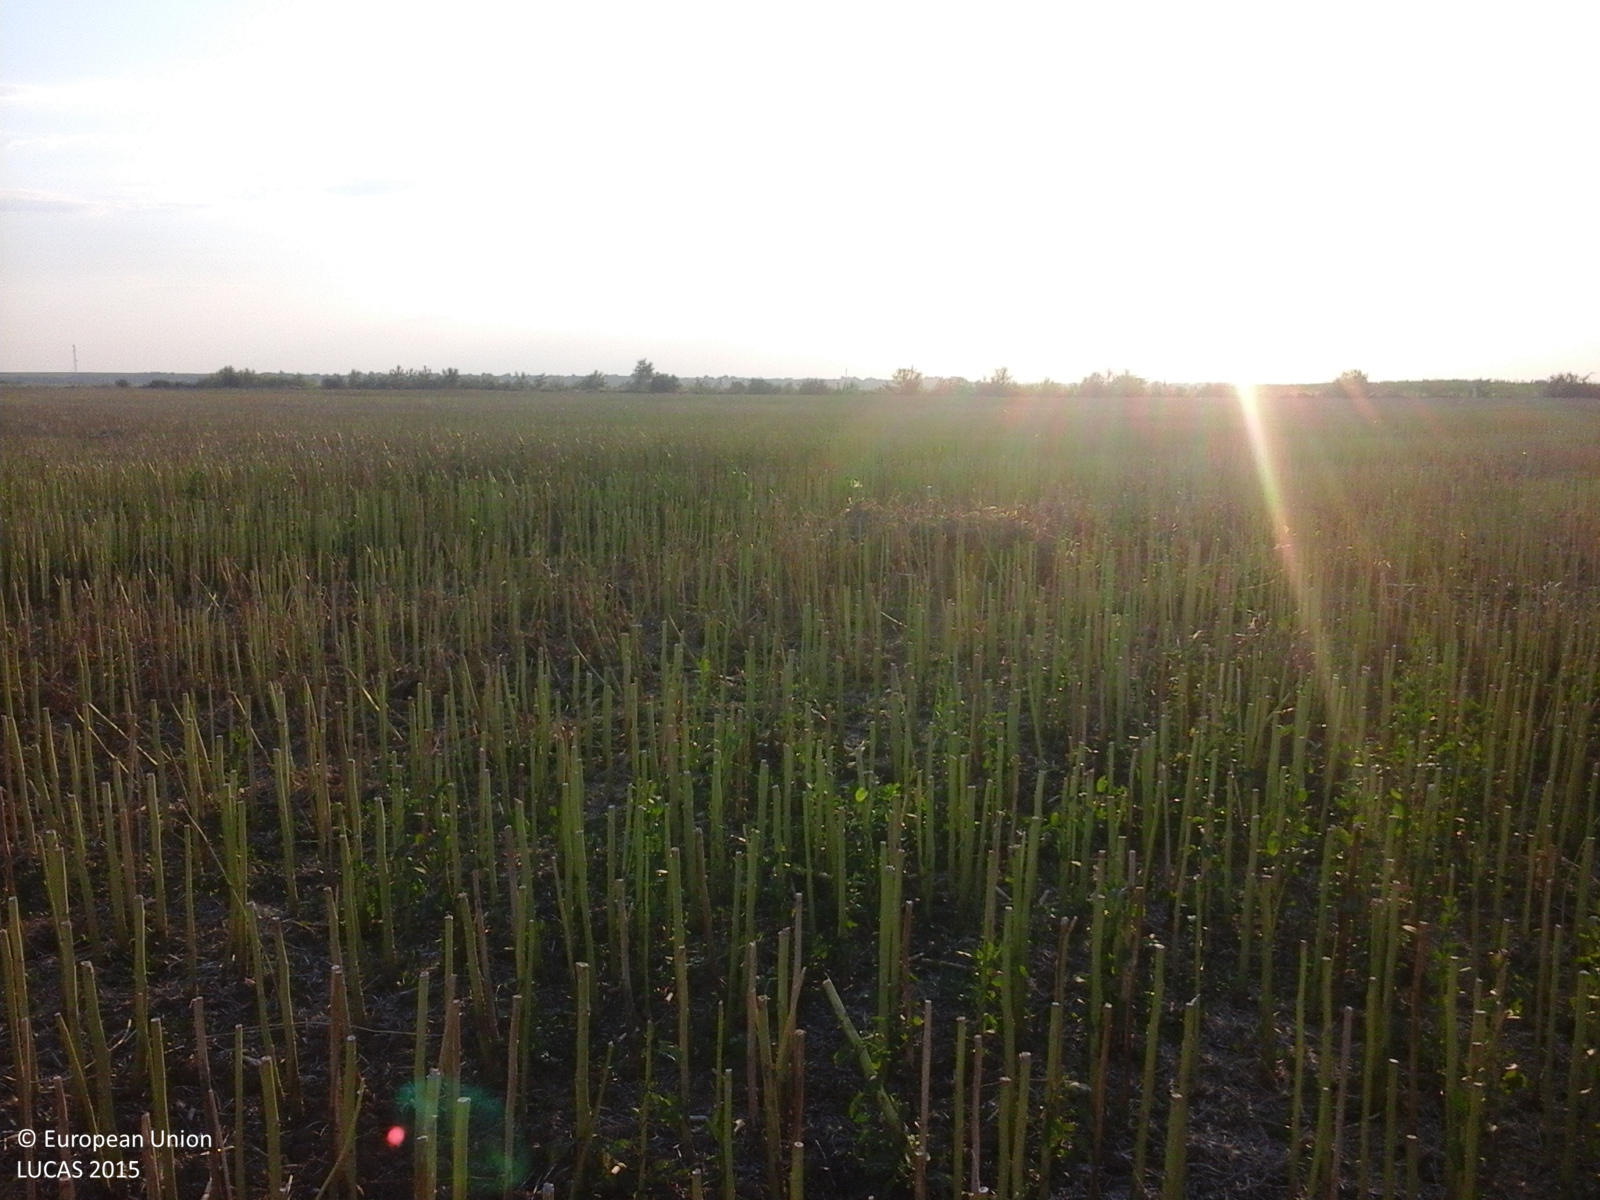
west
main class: Cropland
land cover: Rape and turnip rape
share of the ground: < 10 %
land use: Agriculture (excluding fallow land and kitchen gardens)
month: July
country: RO
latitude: 44.3559
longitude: 24.3315
